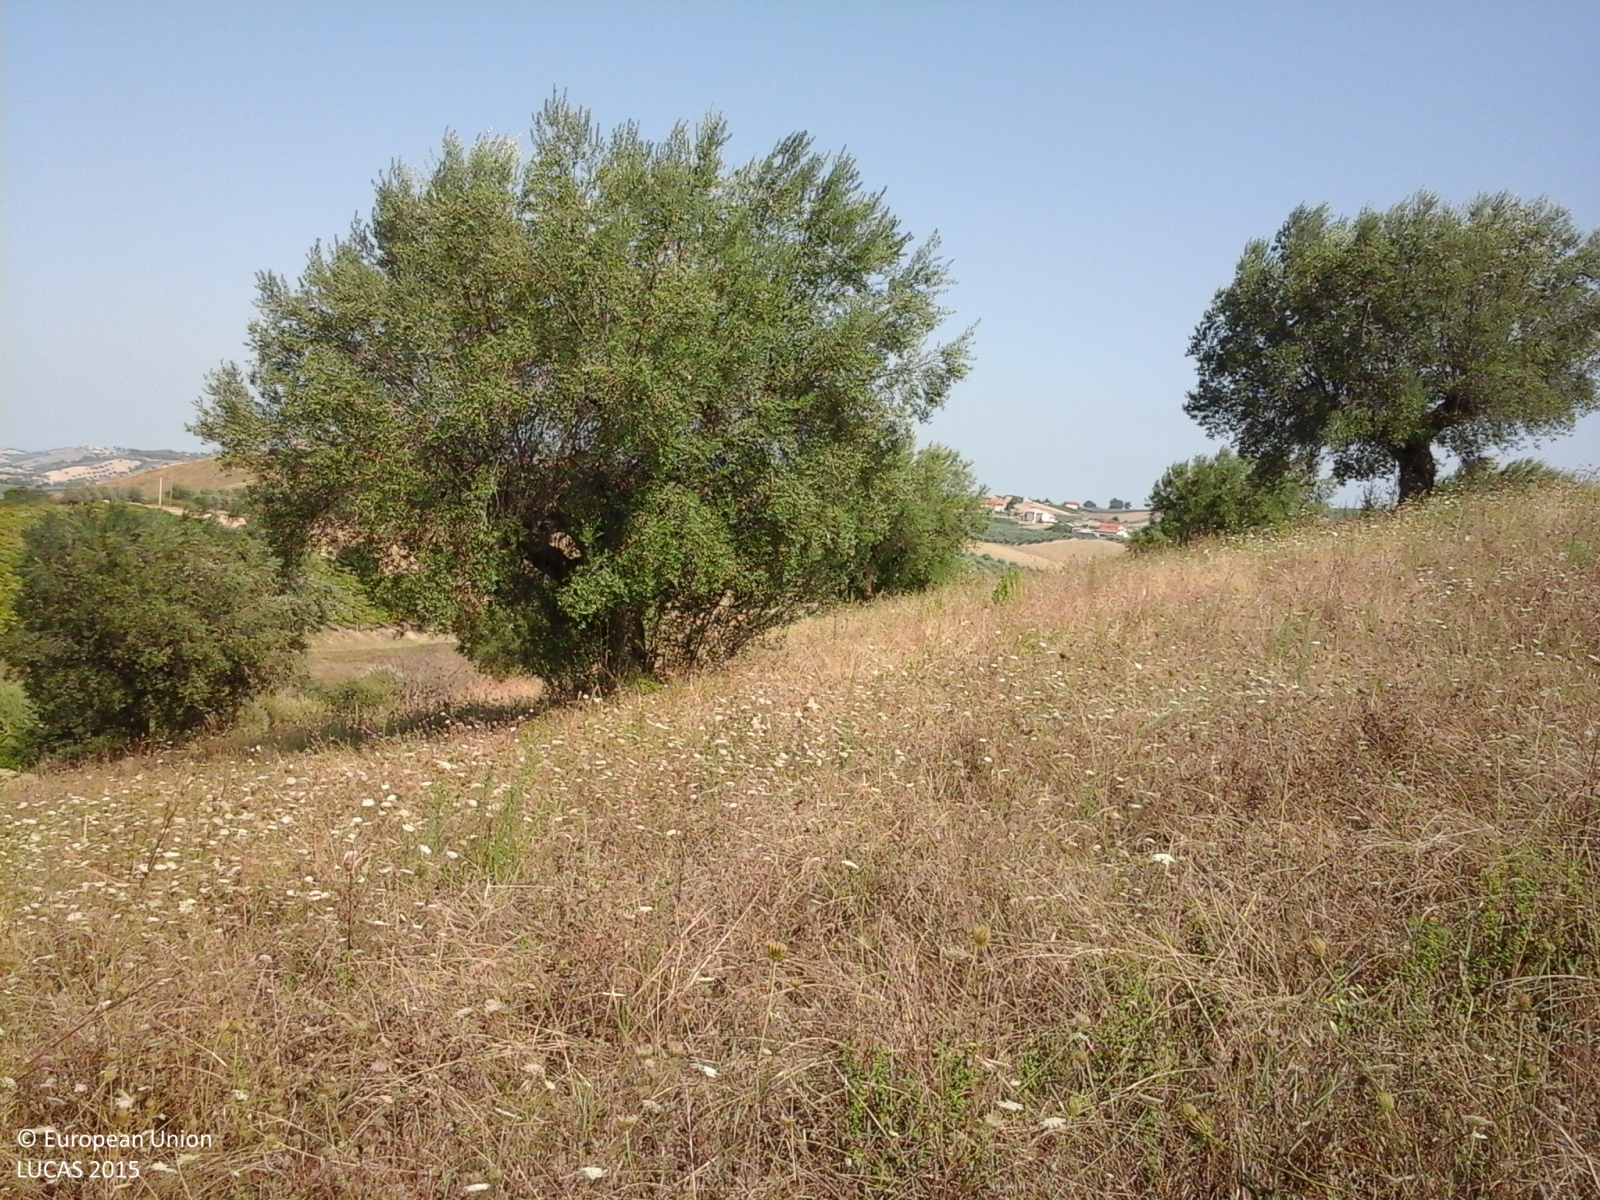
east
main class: Cropland
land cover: Nuts trees
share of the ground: < 10 %
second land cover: Spontaneously vegetated surfaces
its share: > 75 %
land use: Agriculture (excluding fallow land and kitchen gardens)
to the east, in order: Nuts trees; Spontaneously vegetated surfaces; Olive groves; Spontaneously vegetated surfaces; Olive groves; Spontaneously vegetated surfaces; Shrubland with sparse tree cover
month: August
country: IT
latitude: 42.6710
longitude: 13.8568
